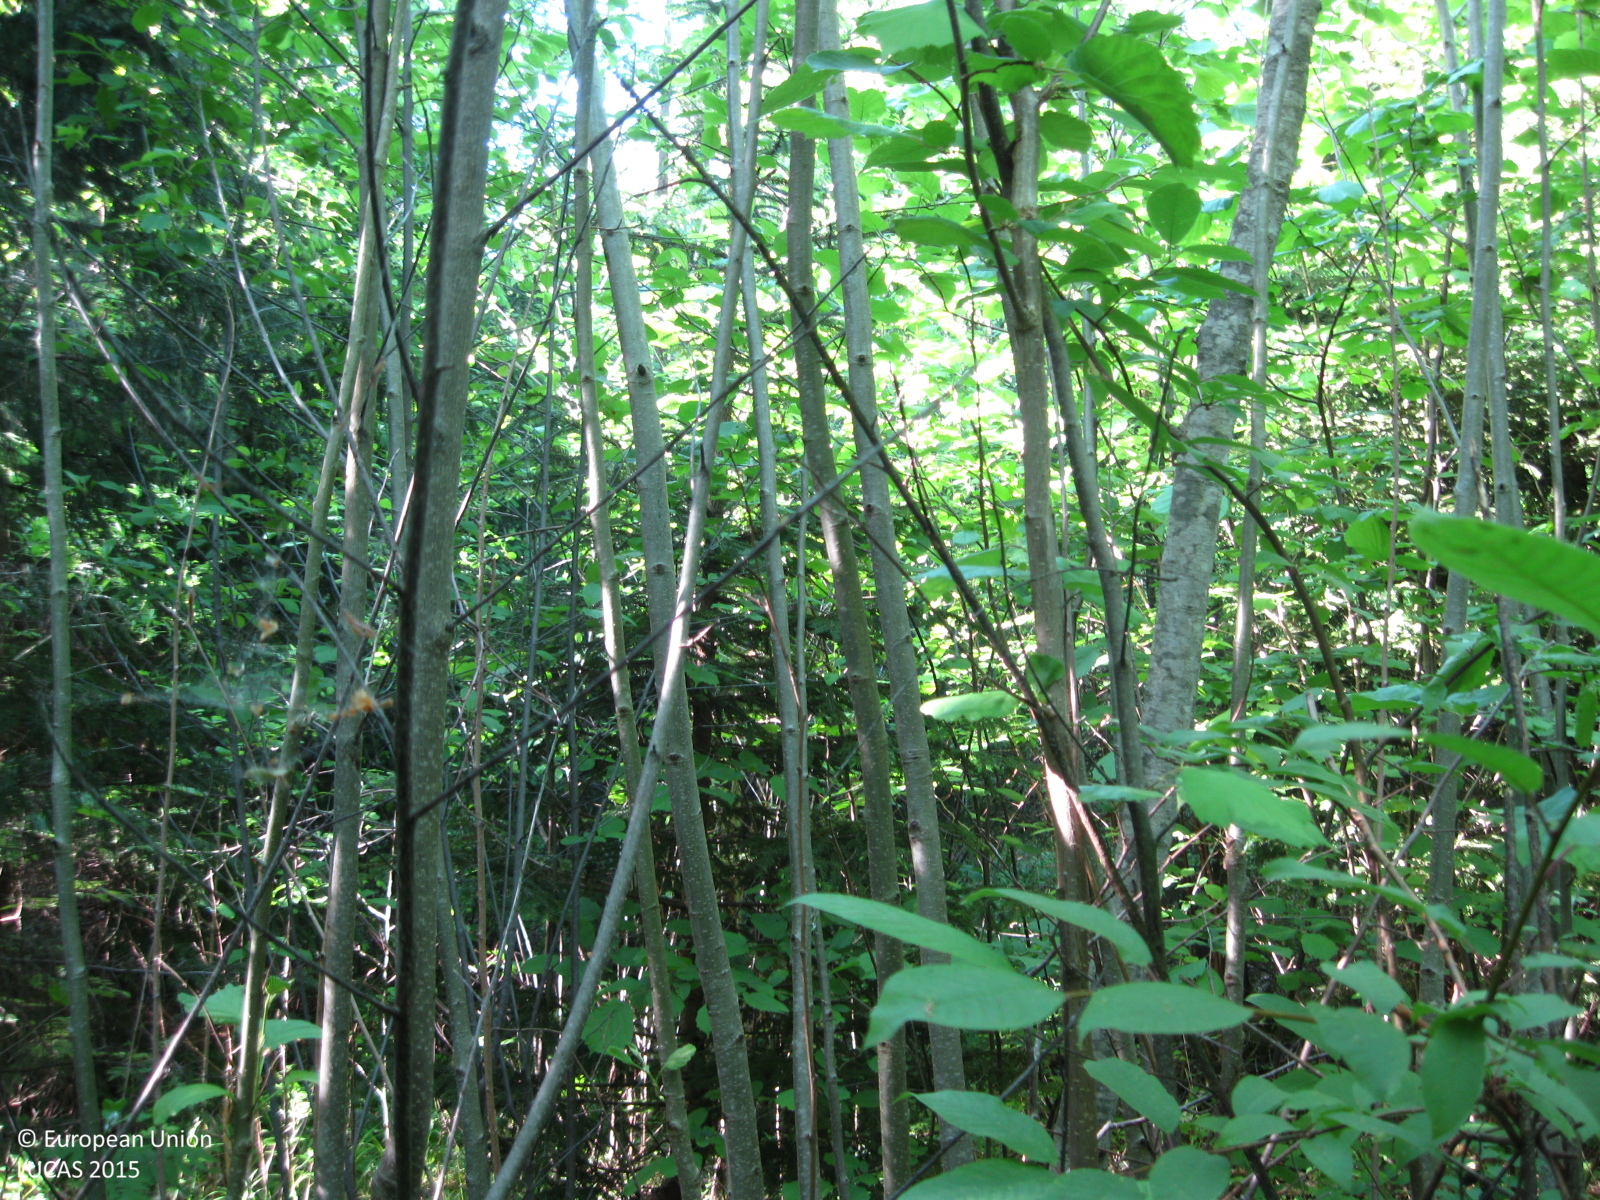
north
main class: Woodland
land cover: Spruce dominated mixed woodland
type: hemiboreal forest and nemoral coniferous forest and mixed broadleaved-coniferous forest
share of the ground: > 75 %
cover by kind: broadleaved forest trees 60 %, coniferous forest trees 30 %, herbaceous plants 10 %
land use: Forestry
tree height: > 5 m
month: June
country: LT
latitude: 55.5678
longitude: 23.6078
